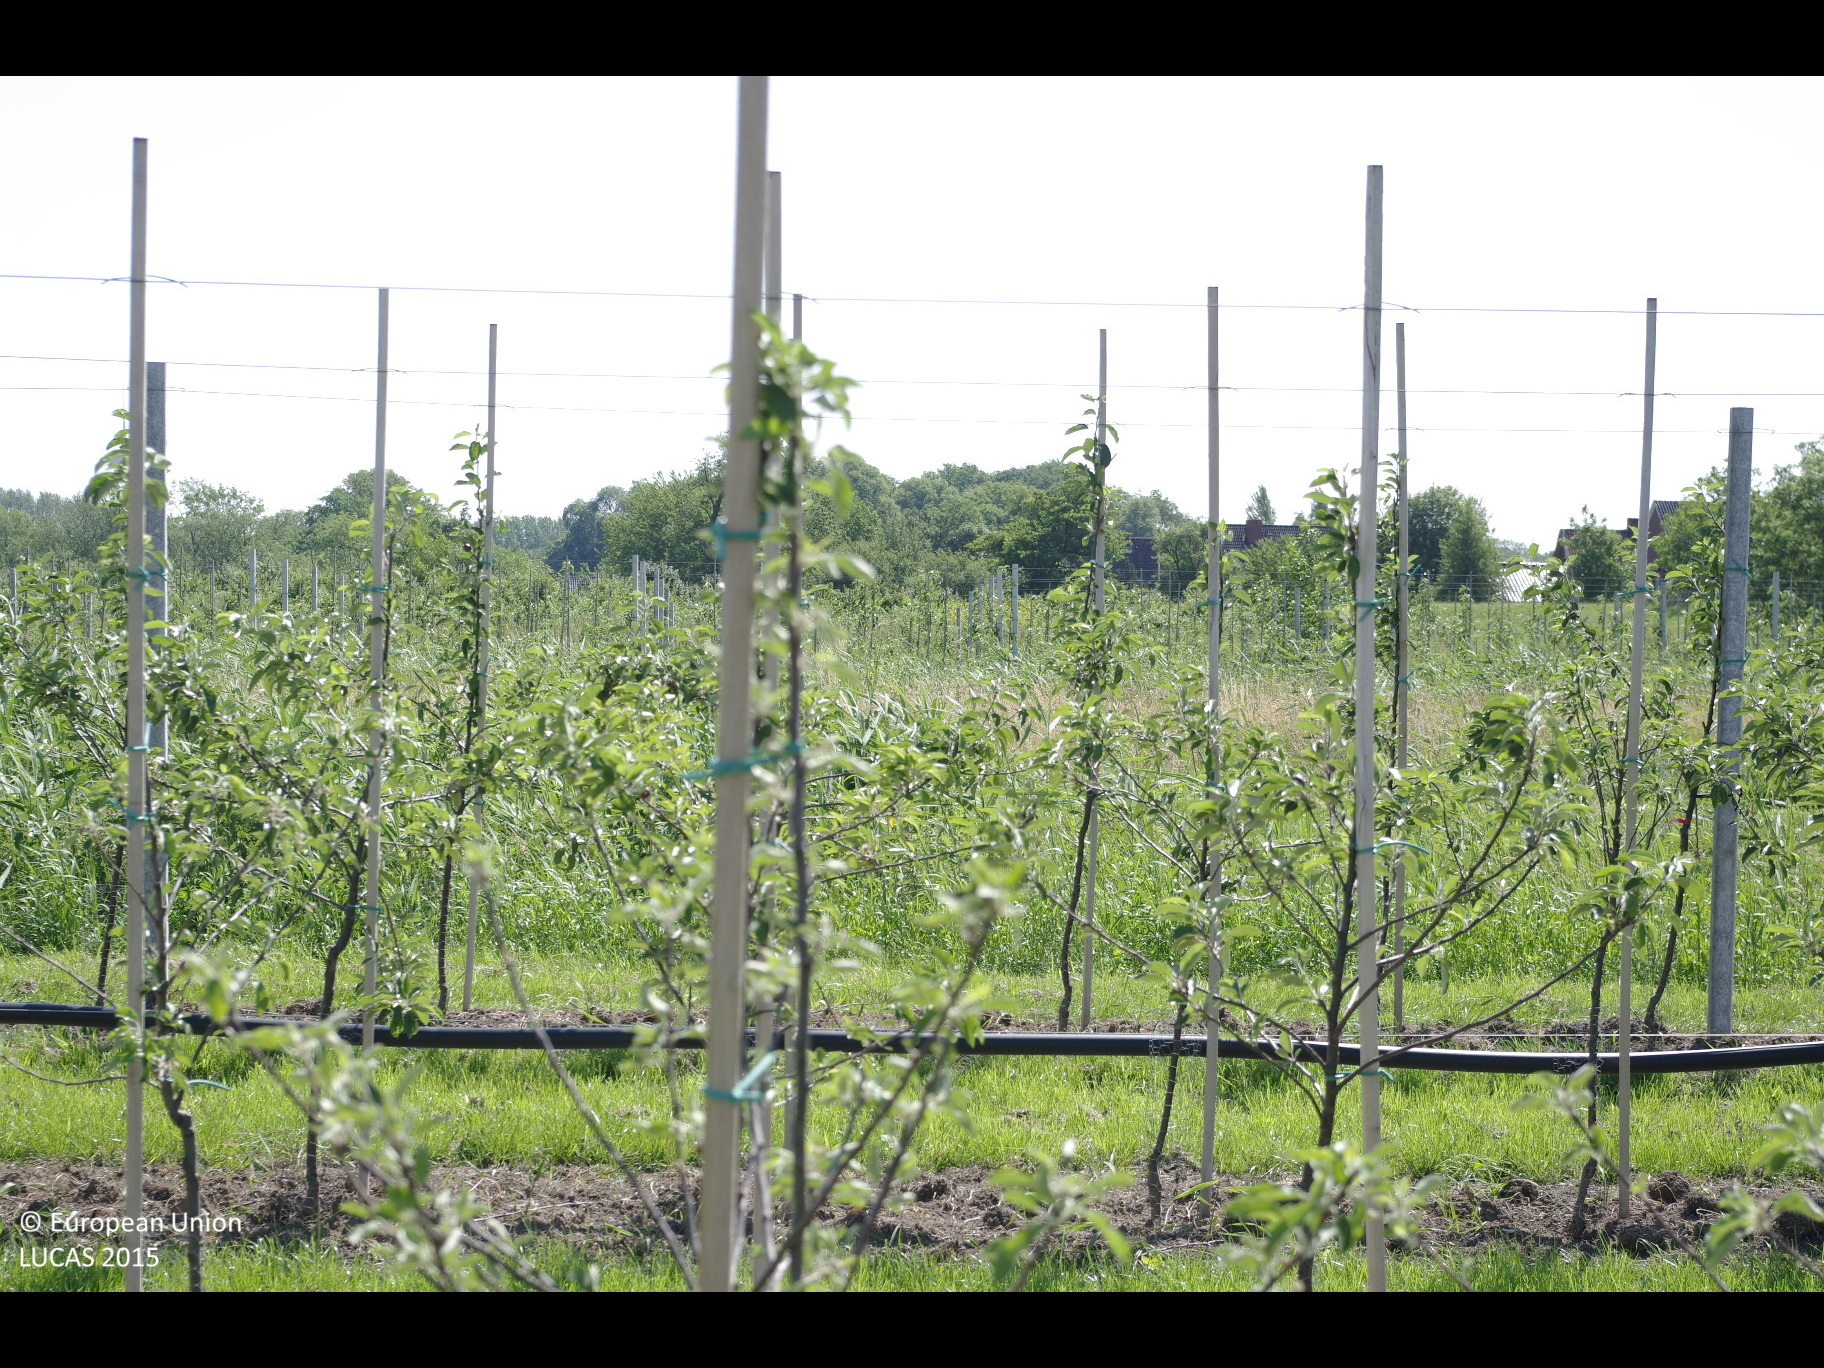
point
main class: Grassland
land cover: Grassland without tree/shrub cover
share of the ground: > 75 %
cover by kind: herbaceous plants 100 %
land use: Agriculture (excluding fallow land and kitchen gardens)
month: July
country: DE
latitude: 53.5097
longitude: 9.8644
